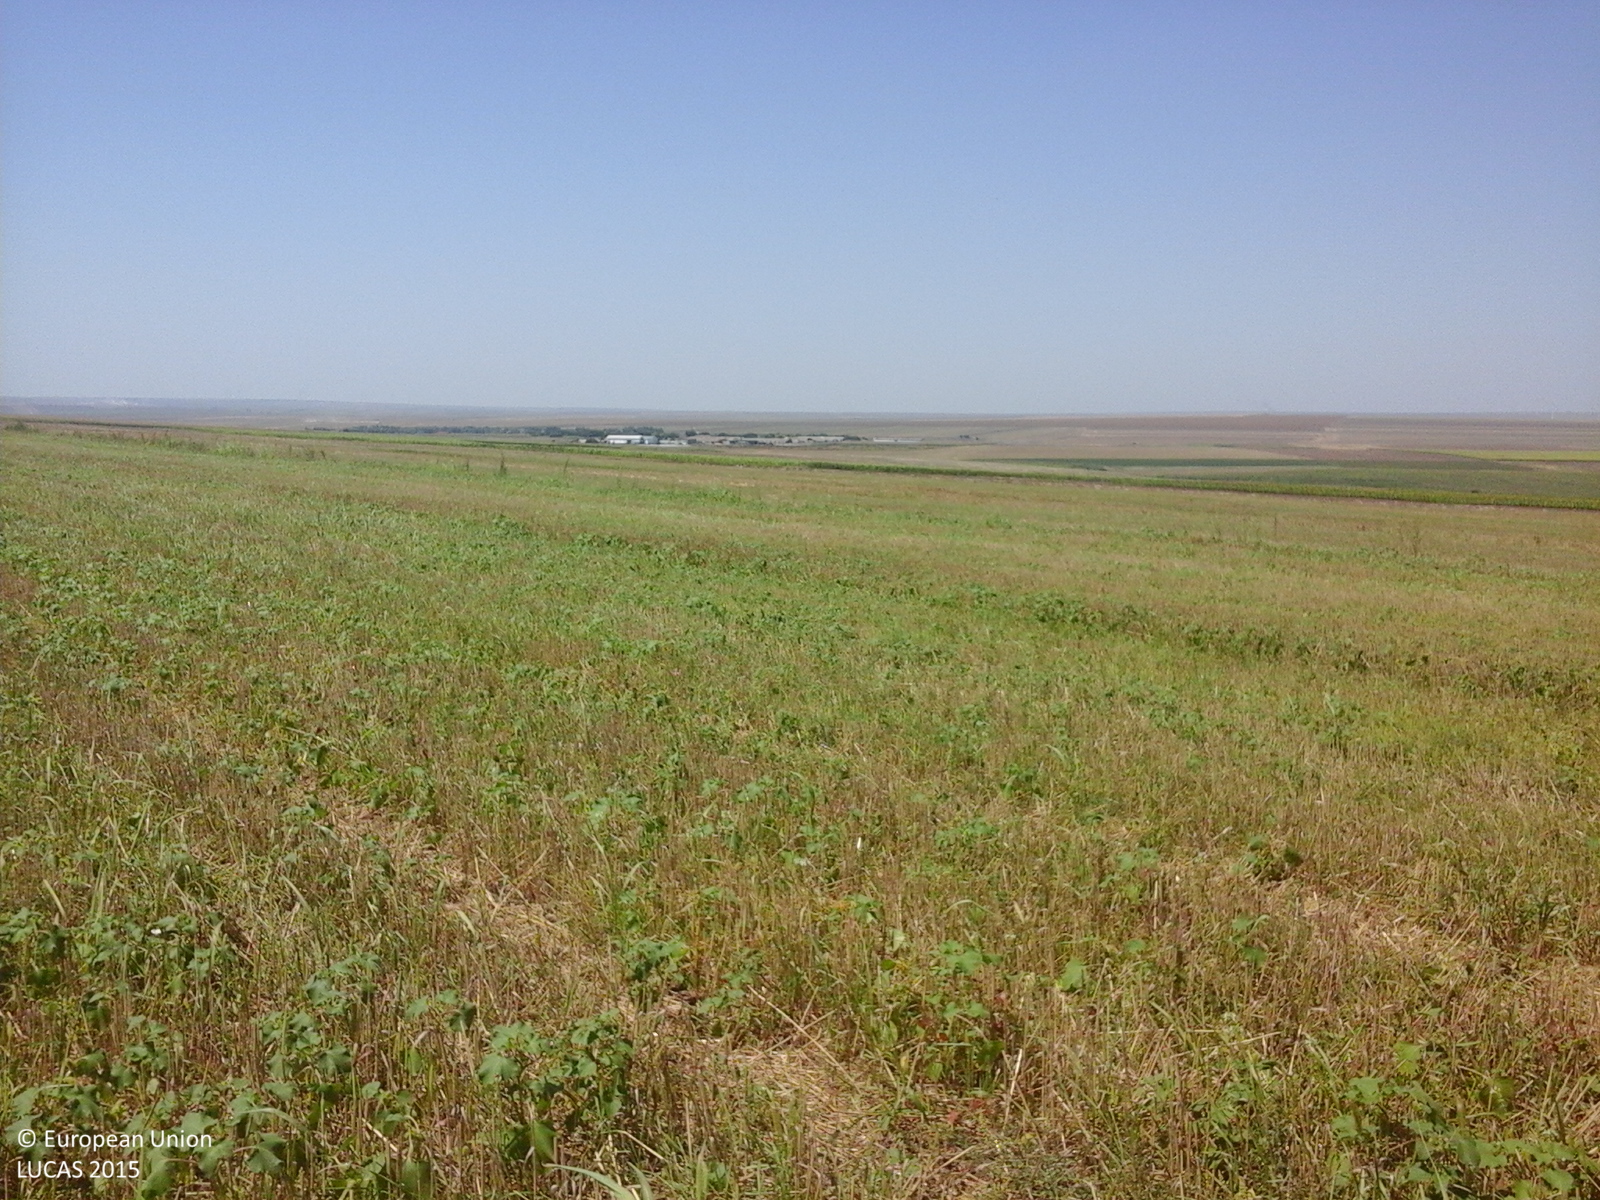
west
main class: Cropland
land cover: Common wheat
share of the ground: > 75 %
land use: Agriculture (excluding fallow land and kitchen gardens)
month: August
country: RO
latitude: 44.6285
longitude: 28.4896
